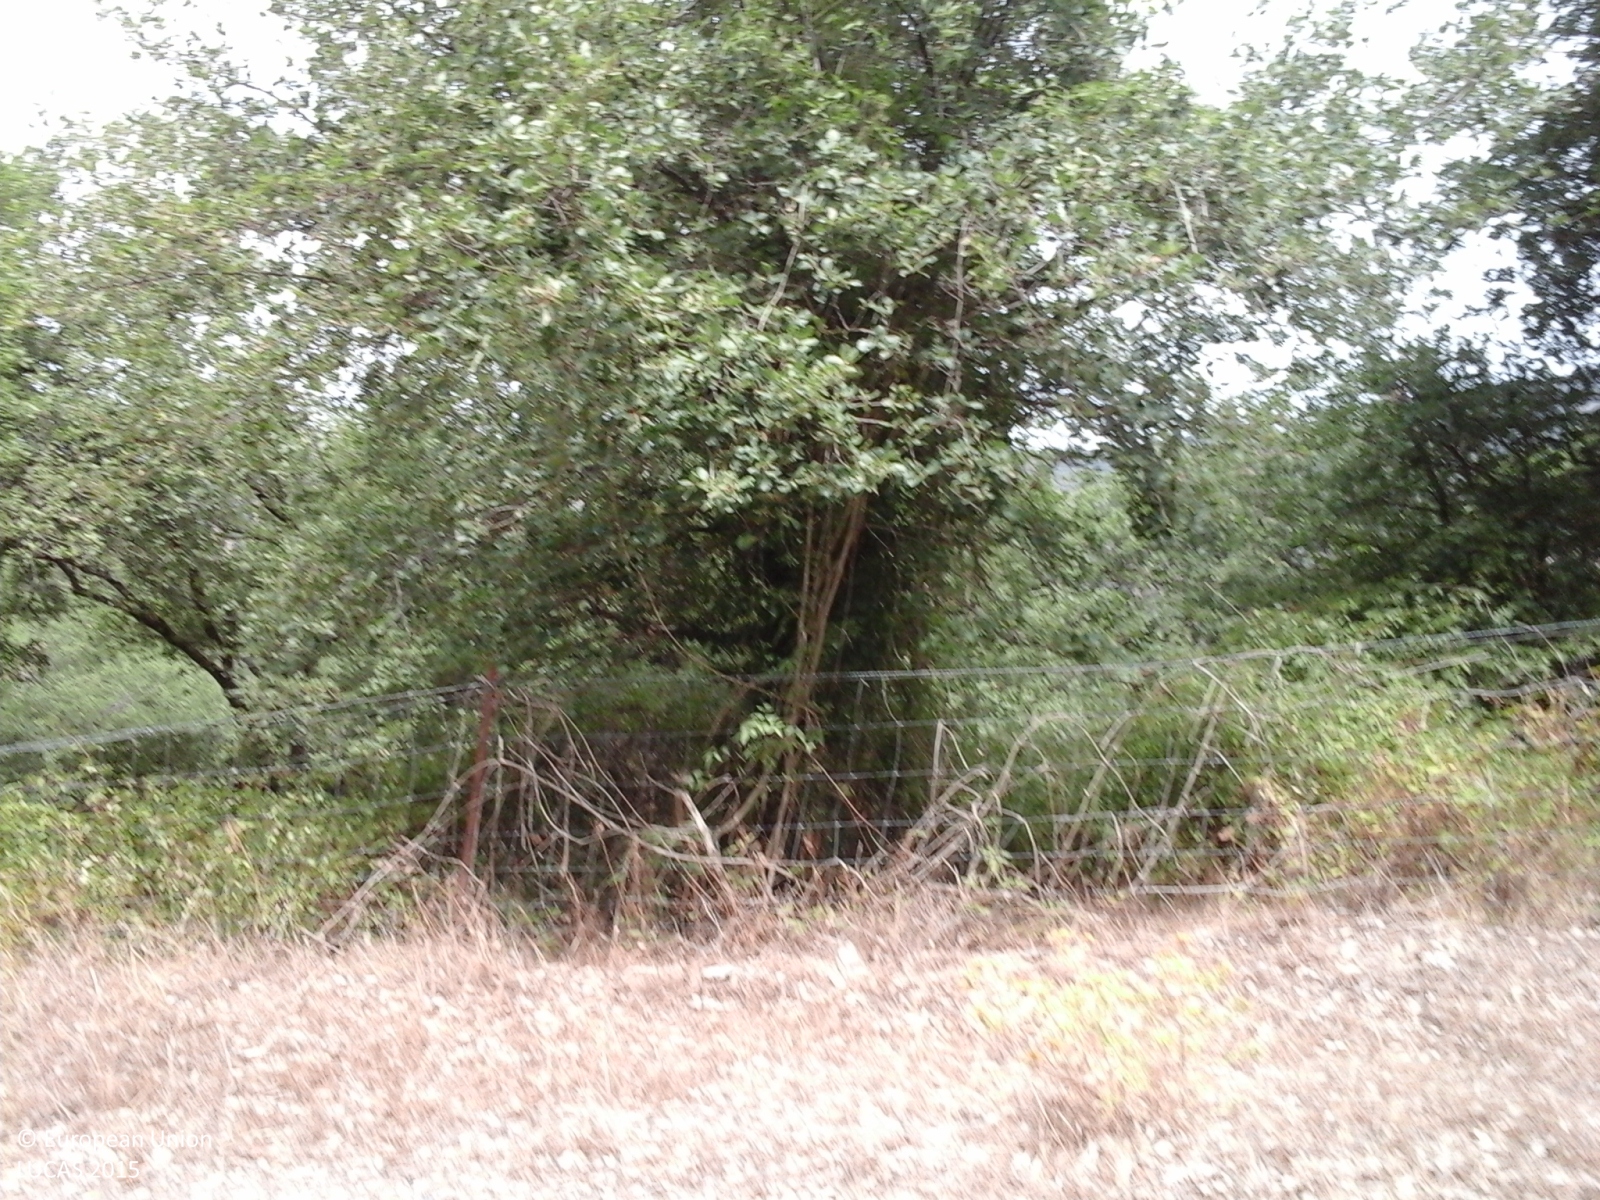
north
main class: Woodland
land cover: Broadleaved woodland
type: broadleaved evergreen forest
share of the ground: > 75 %
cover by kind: broadleaved forest trees 100 %
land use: Forestry
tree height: < 5 m
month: August
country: IT
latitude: 39.9550
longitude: 9.0571
